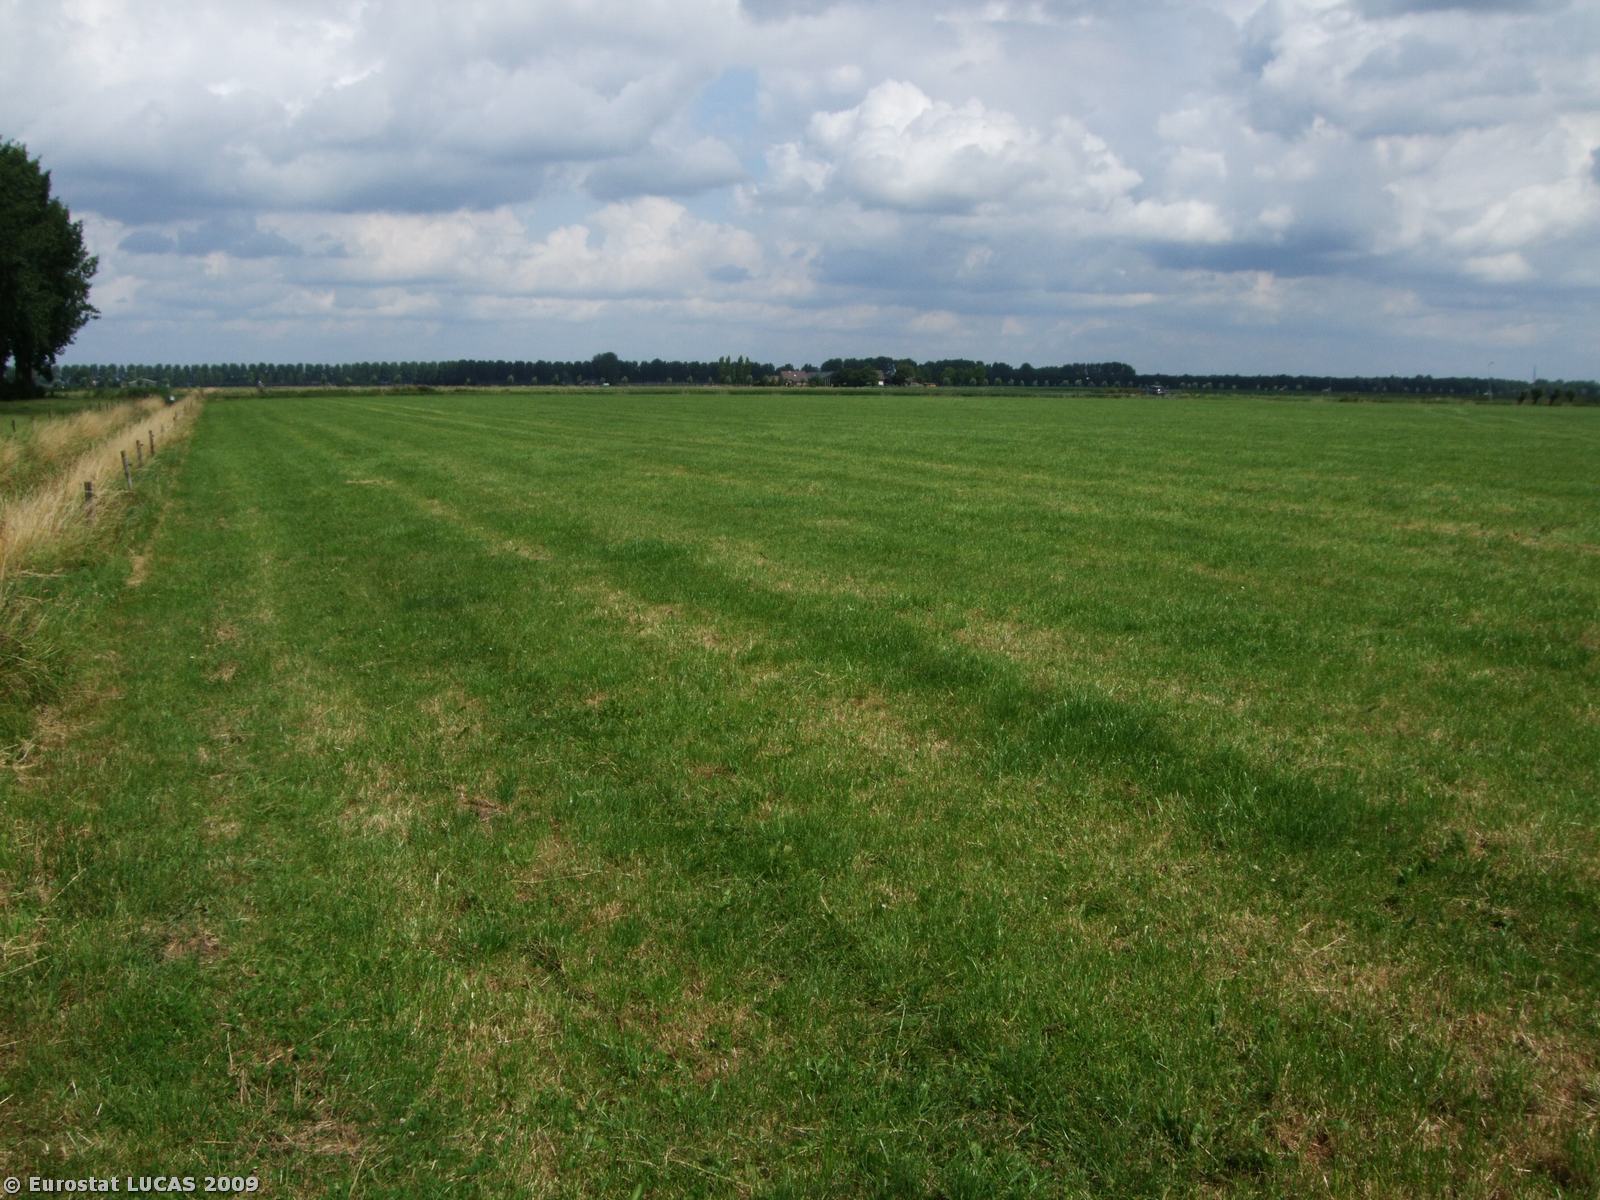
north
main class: Grassland
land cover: Grassland without tree/shrub cover
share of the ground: > 75 %
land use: Agriculture (excluding fallow land and kitchen gardens)
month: July
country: NL
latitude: 51.9267
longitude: 5.3591
